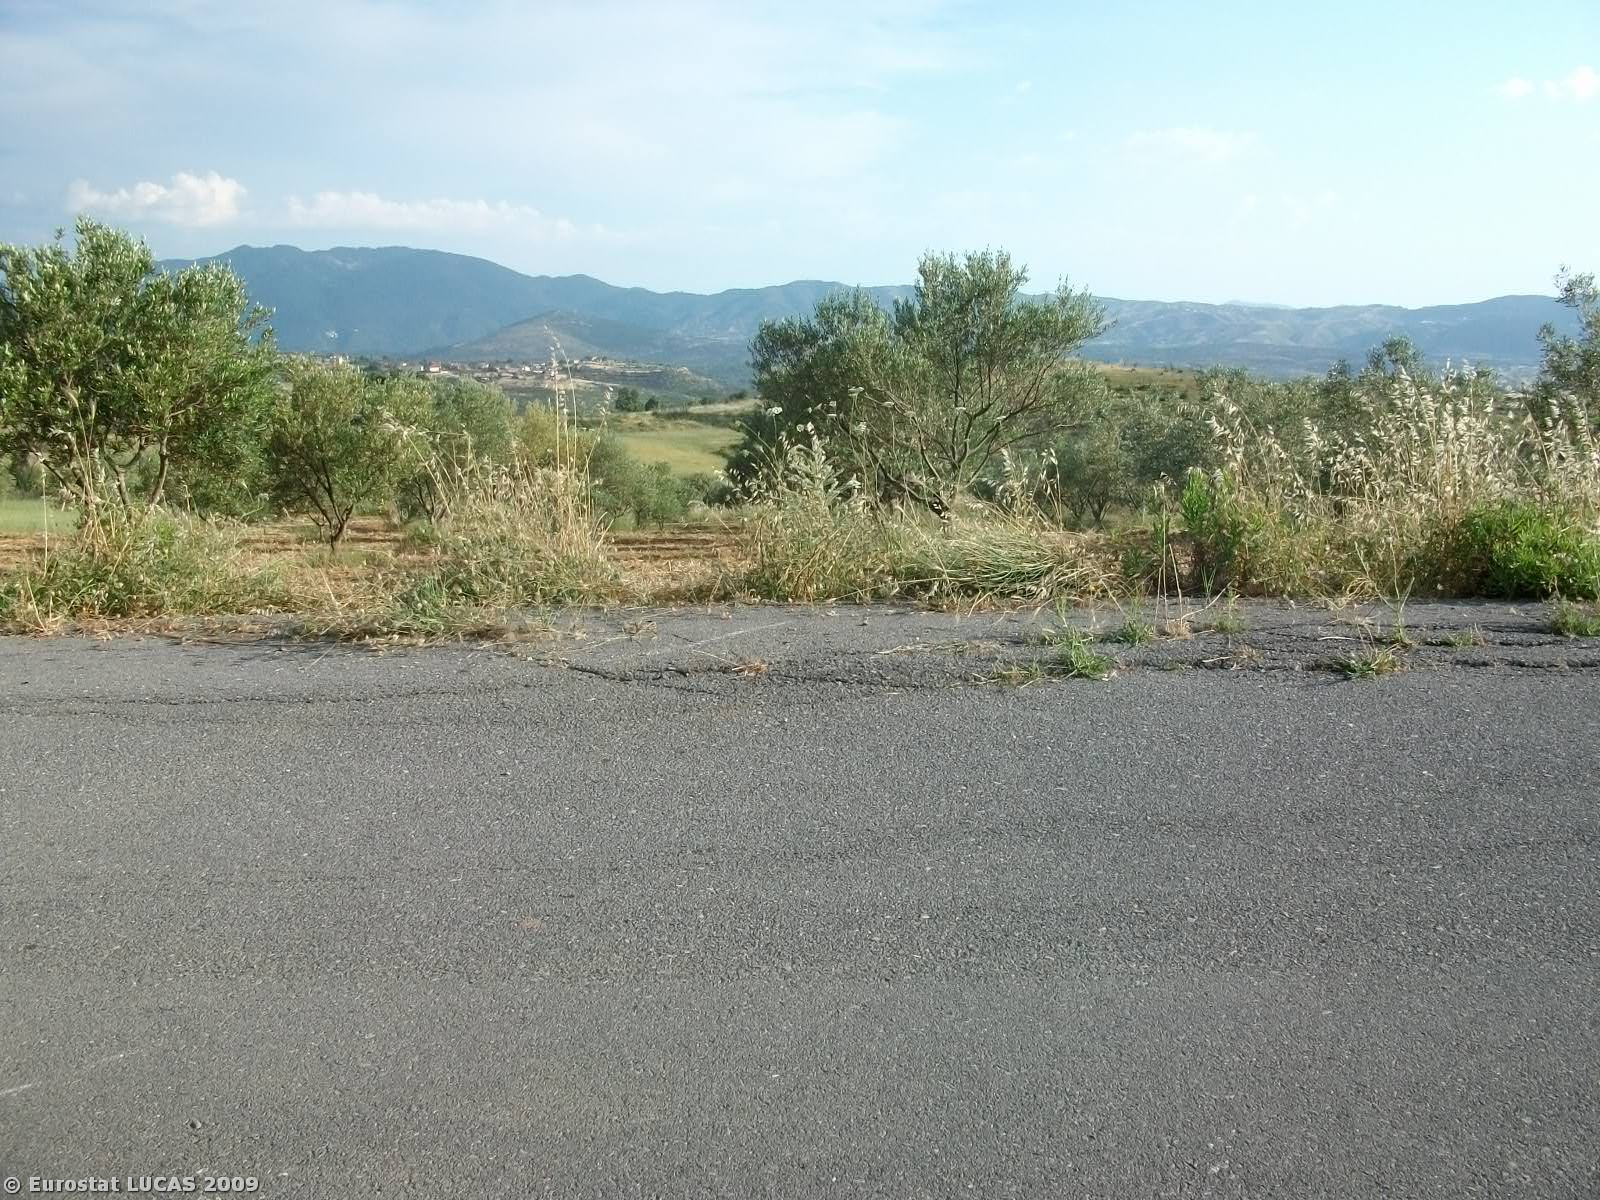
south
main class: Grassland
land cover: Grassland with sparse tree/shrub cover
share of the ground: 50 - 75 %
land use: Unused
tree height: < 5 m
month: June
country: GR
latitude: 37.3429
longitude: 22.2058
